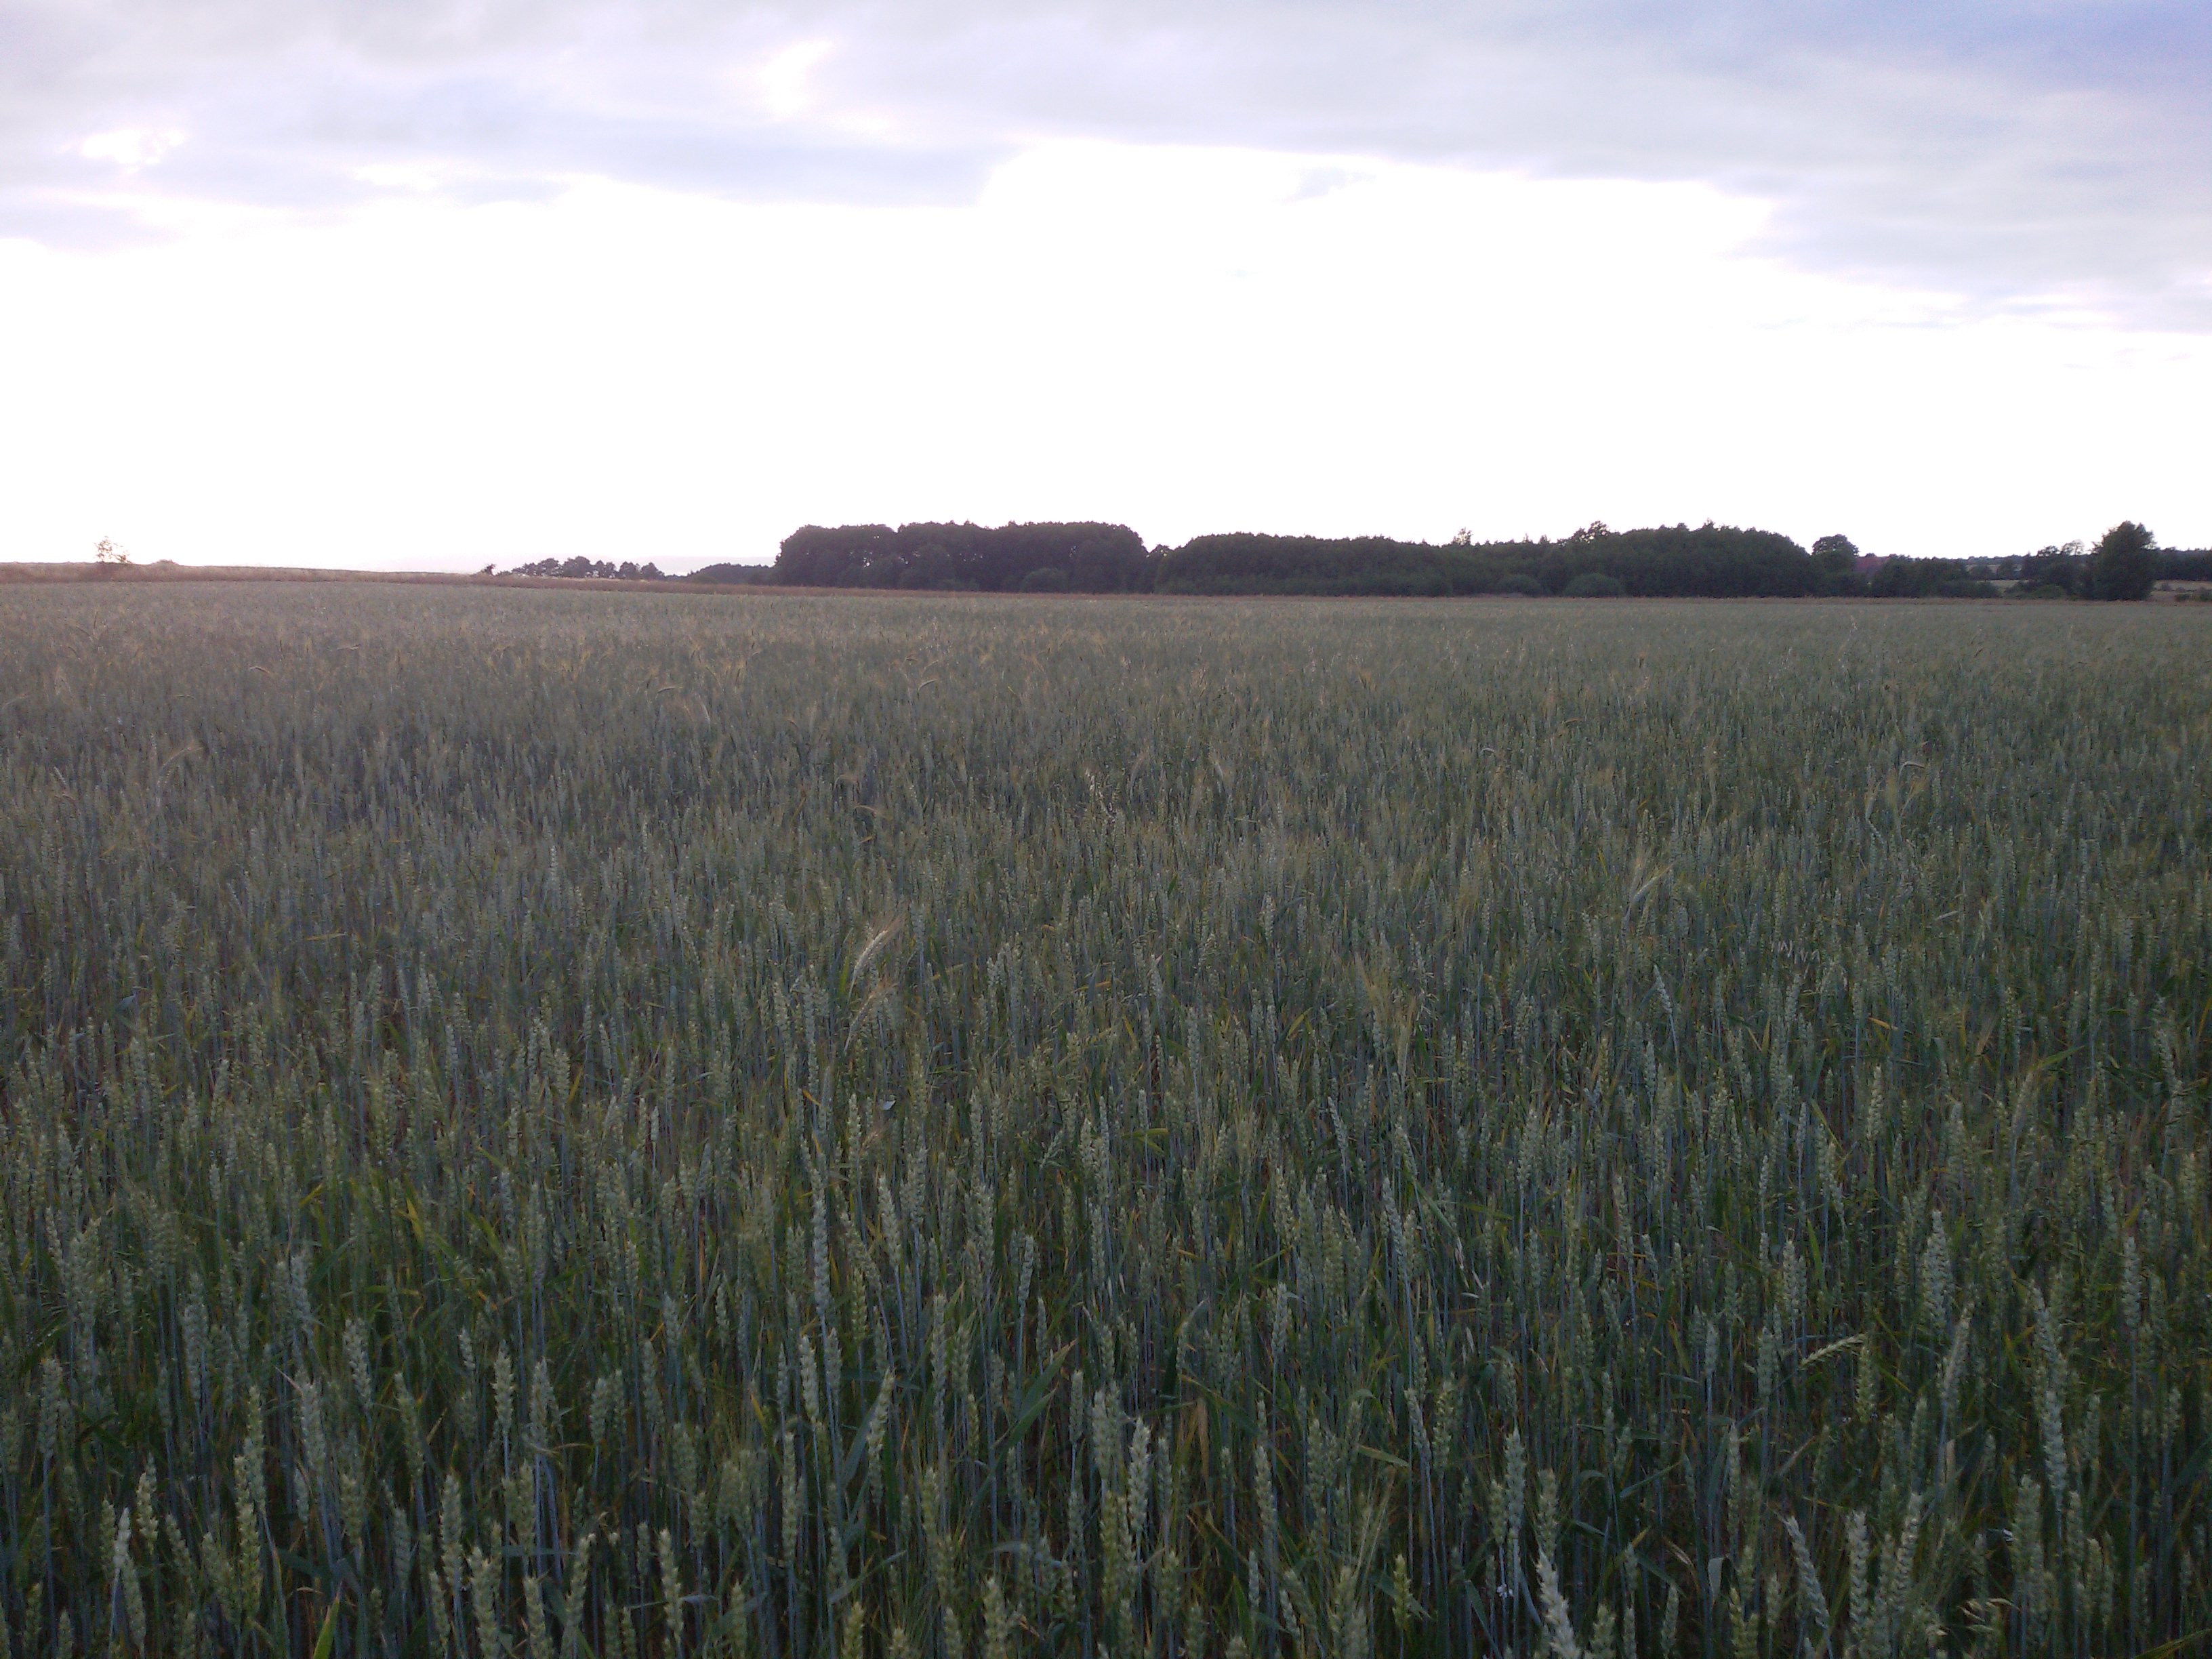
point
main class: Cropland
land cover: Common wheat
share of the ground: > 75 %
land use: Agriculture (excluding fallow land and kitchen gardens)
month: June
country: PL
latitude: 50.6599
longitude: 17.2116
